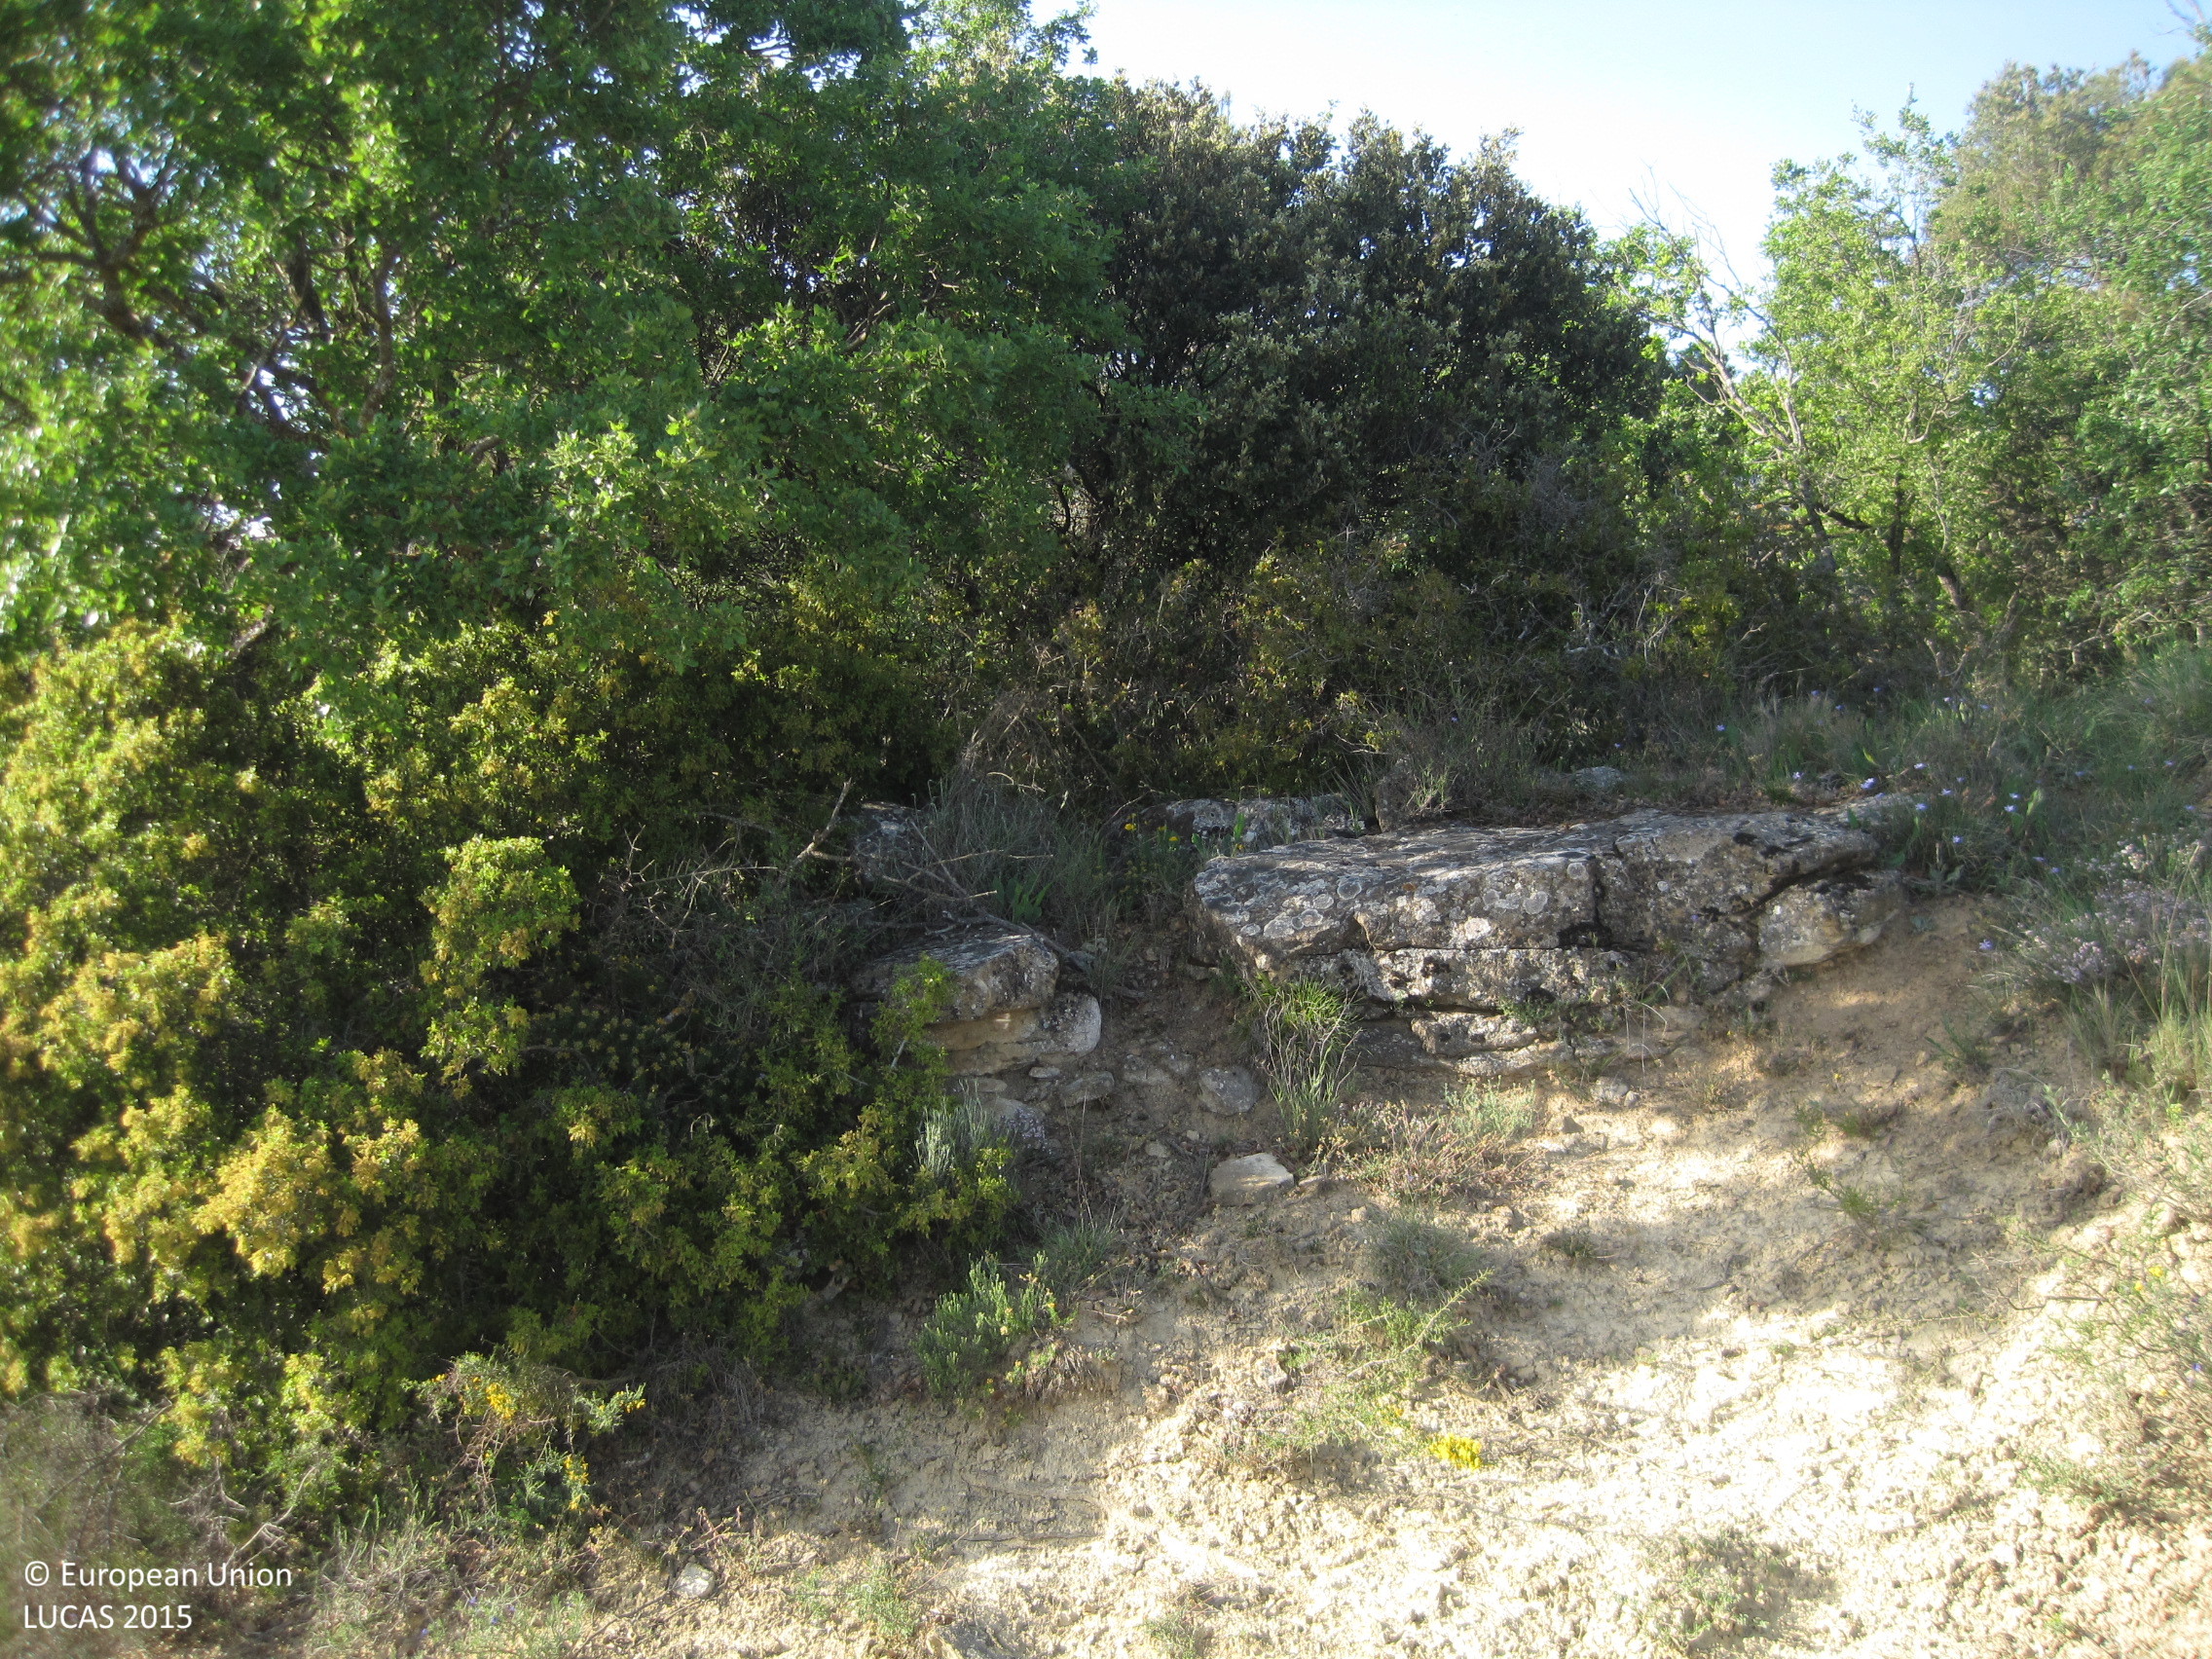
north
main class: Shrubland
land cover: Shrubland with sparse tree cover
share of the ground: > 75 %
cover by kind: shrubs 55 %, herbaceous plants 30 %, unconsolidated bare surface 10 %, broadleaved forest trees 5 %
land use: Semi-natural and natural areas not in use
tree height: < 5 m
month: May
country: ES
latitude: 42.6110
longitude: -1.7038
